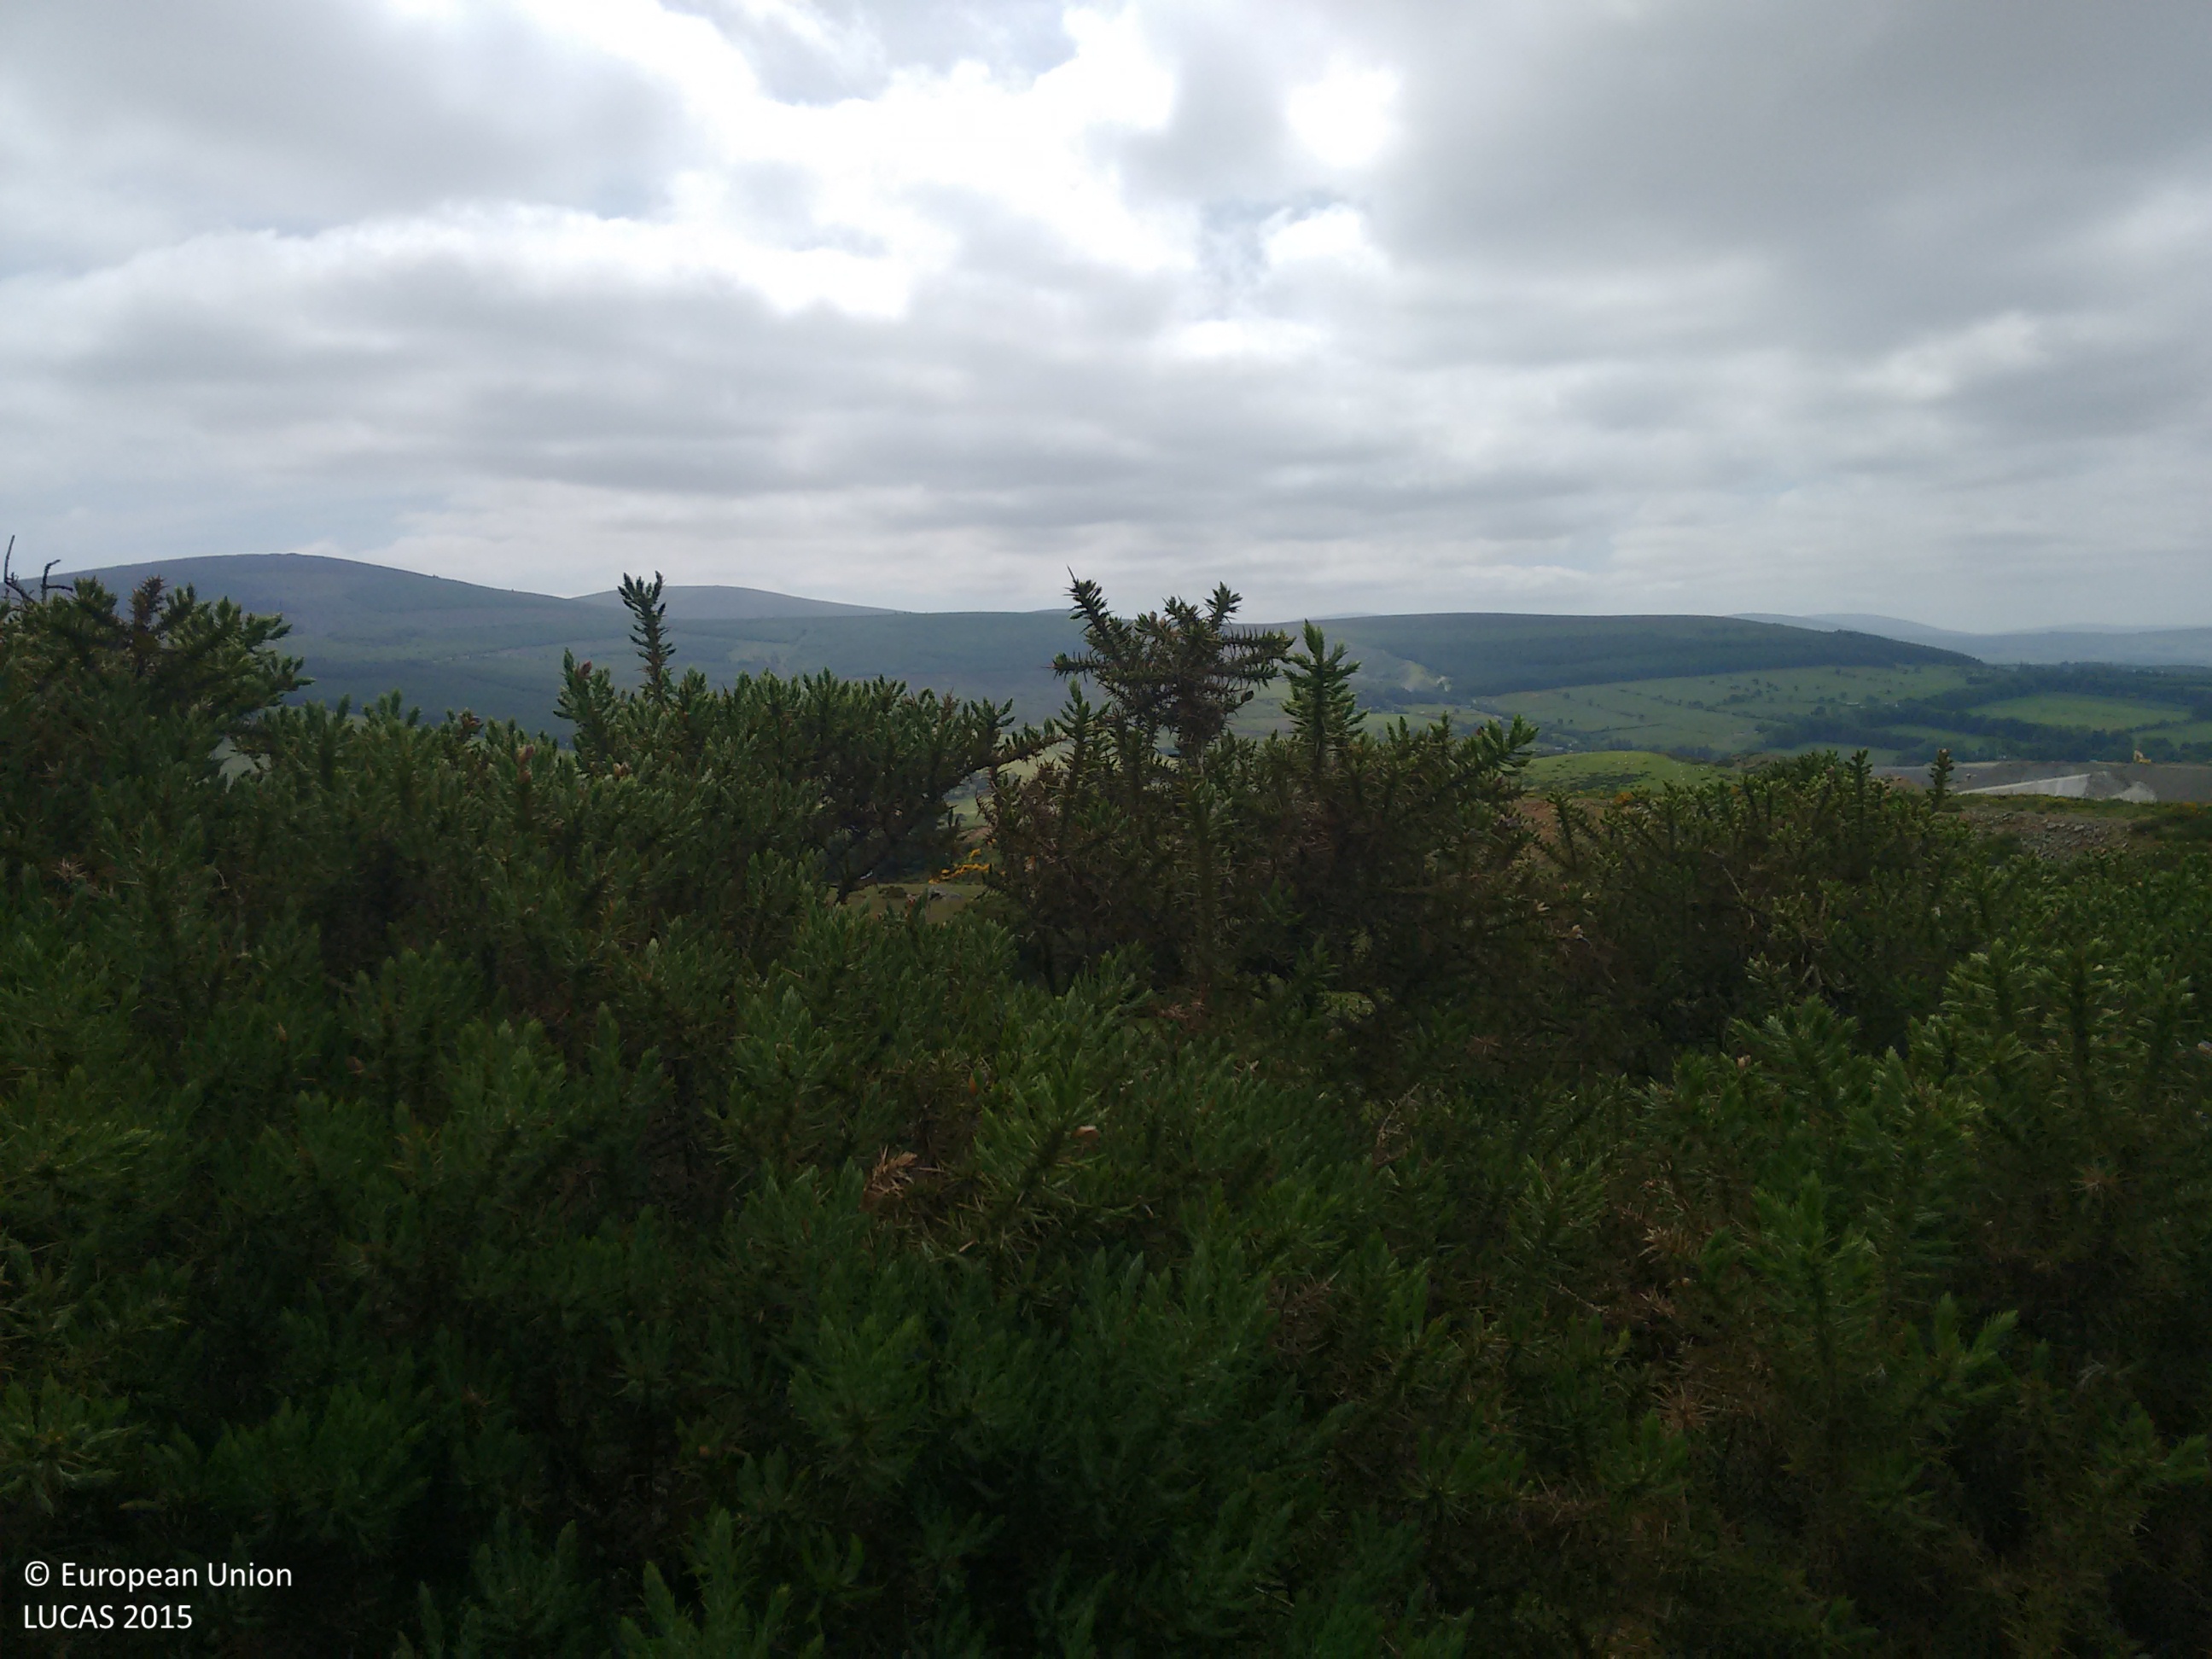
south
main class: Shrubland
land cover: Shrubland without tree cover
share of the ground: > 75 %
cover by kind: herbaceous plants 75 %, shrubs 25 %
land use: Agriculture (excluding fallow land and kitchen gardens)
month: June
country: IE
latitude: 53.2445
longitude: -6.4137
